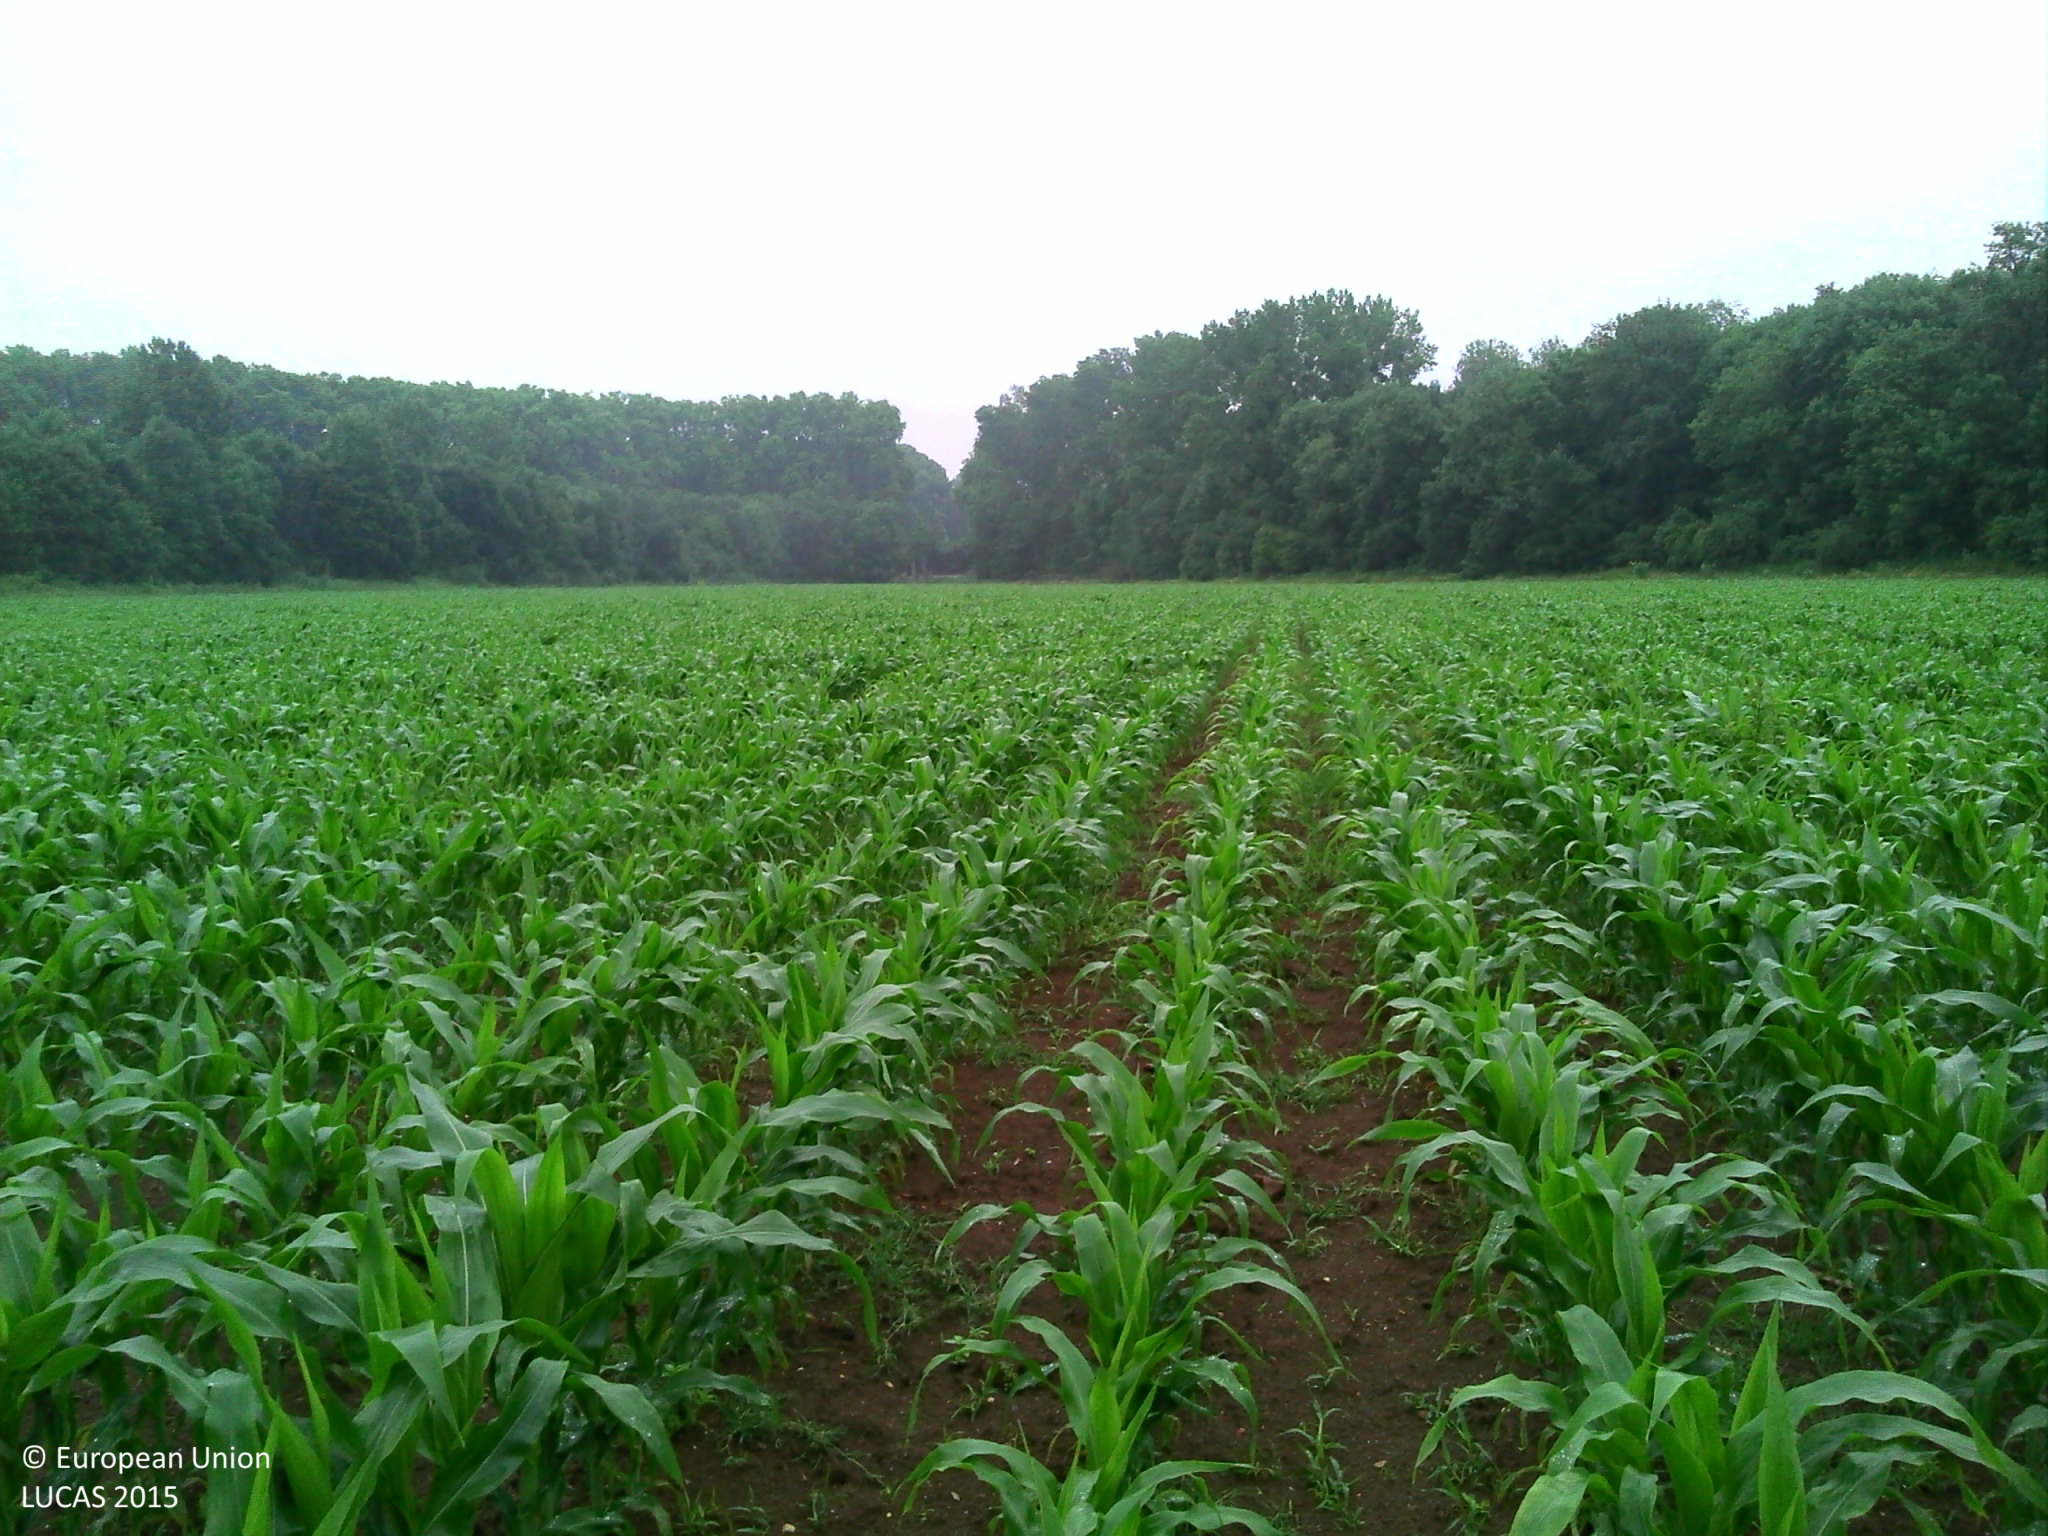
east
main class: Cropland
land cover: Maize
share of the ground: 25 - 50 %
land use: Agriculture (excluding fallow land and kitchen gardens)
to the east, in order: Maize
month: June
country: FR
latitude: 46.7000
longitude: 0.4209
